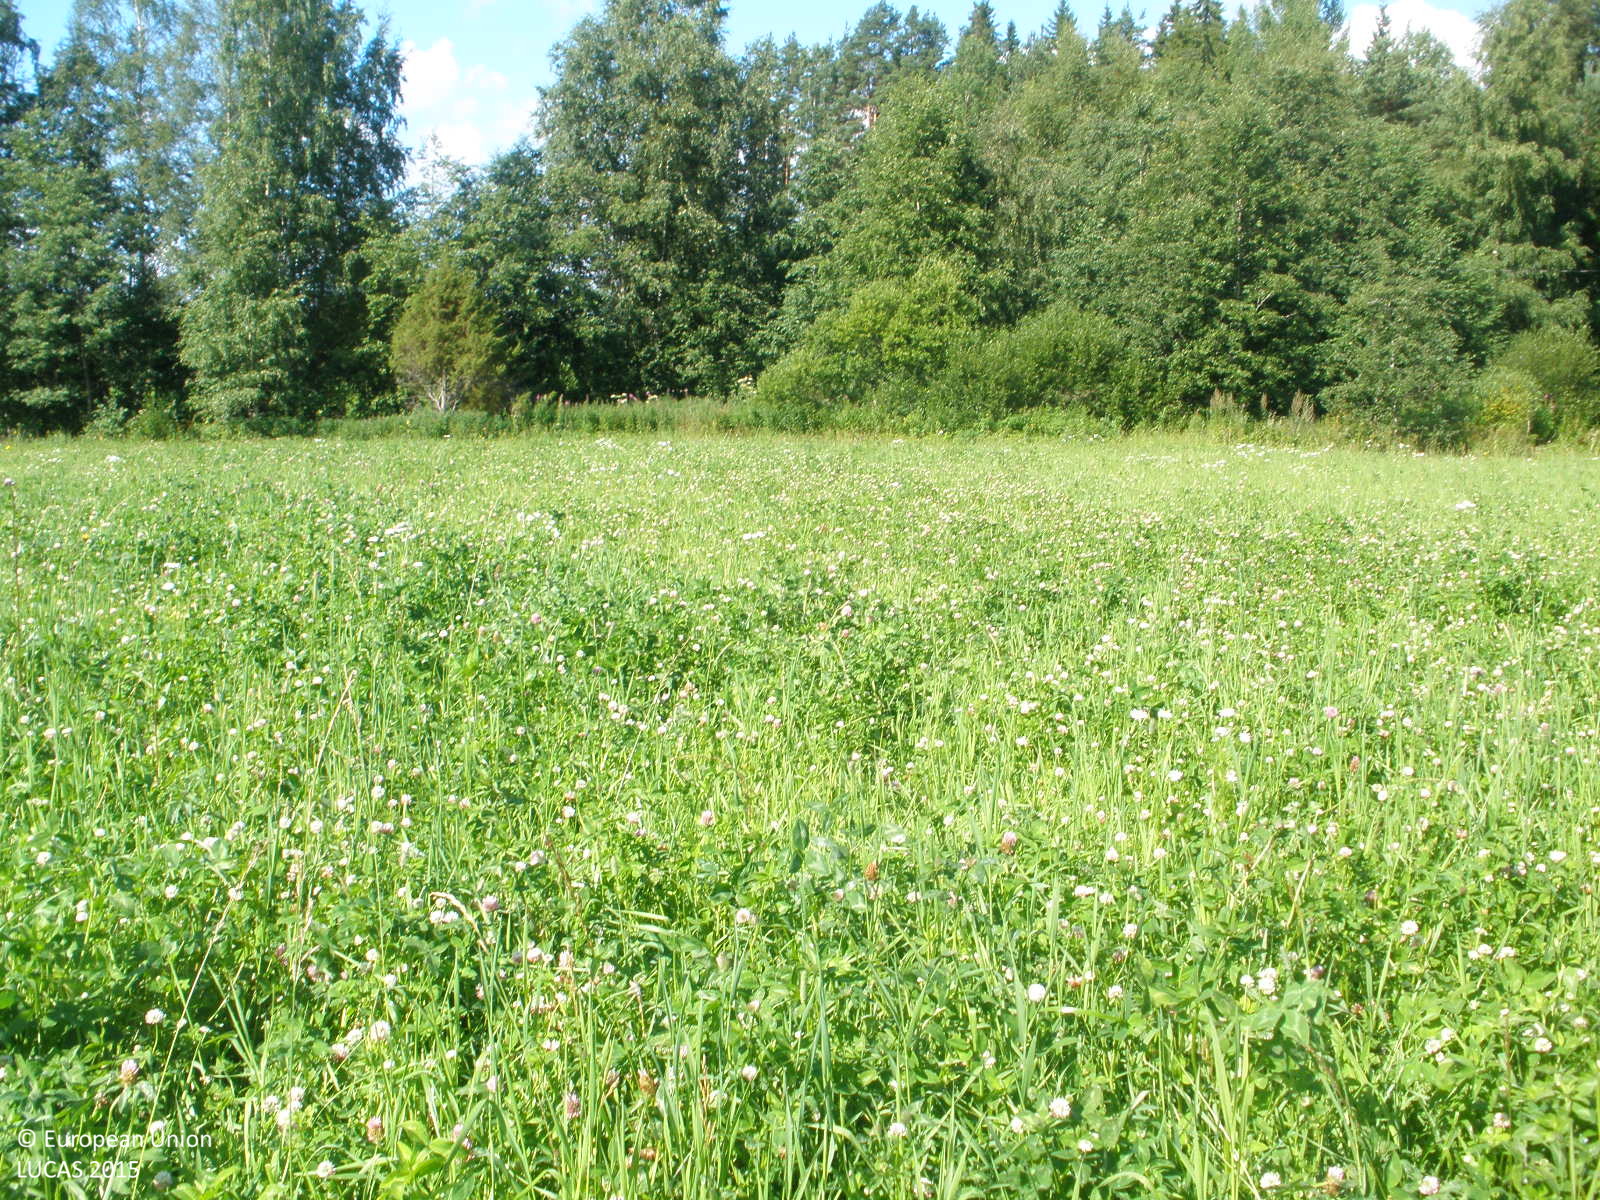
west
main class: Cropland
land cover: Other leguminous and mixtures for fodder
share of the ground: > 75 %
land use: Agriculture (excluding fallow land and kitchen gardens)
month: August
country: FI
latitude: 60.9551
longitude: 24.9775
